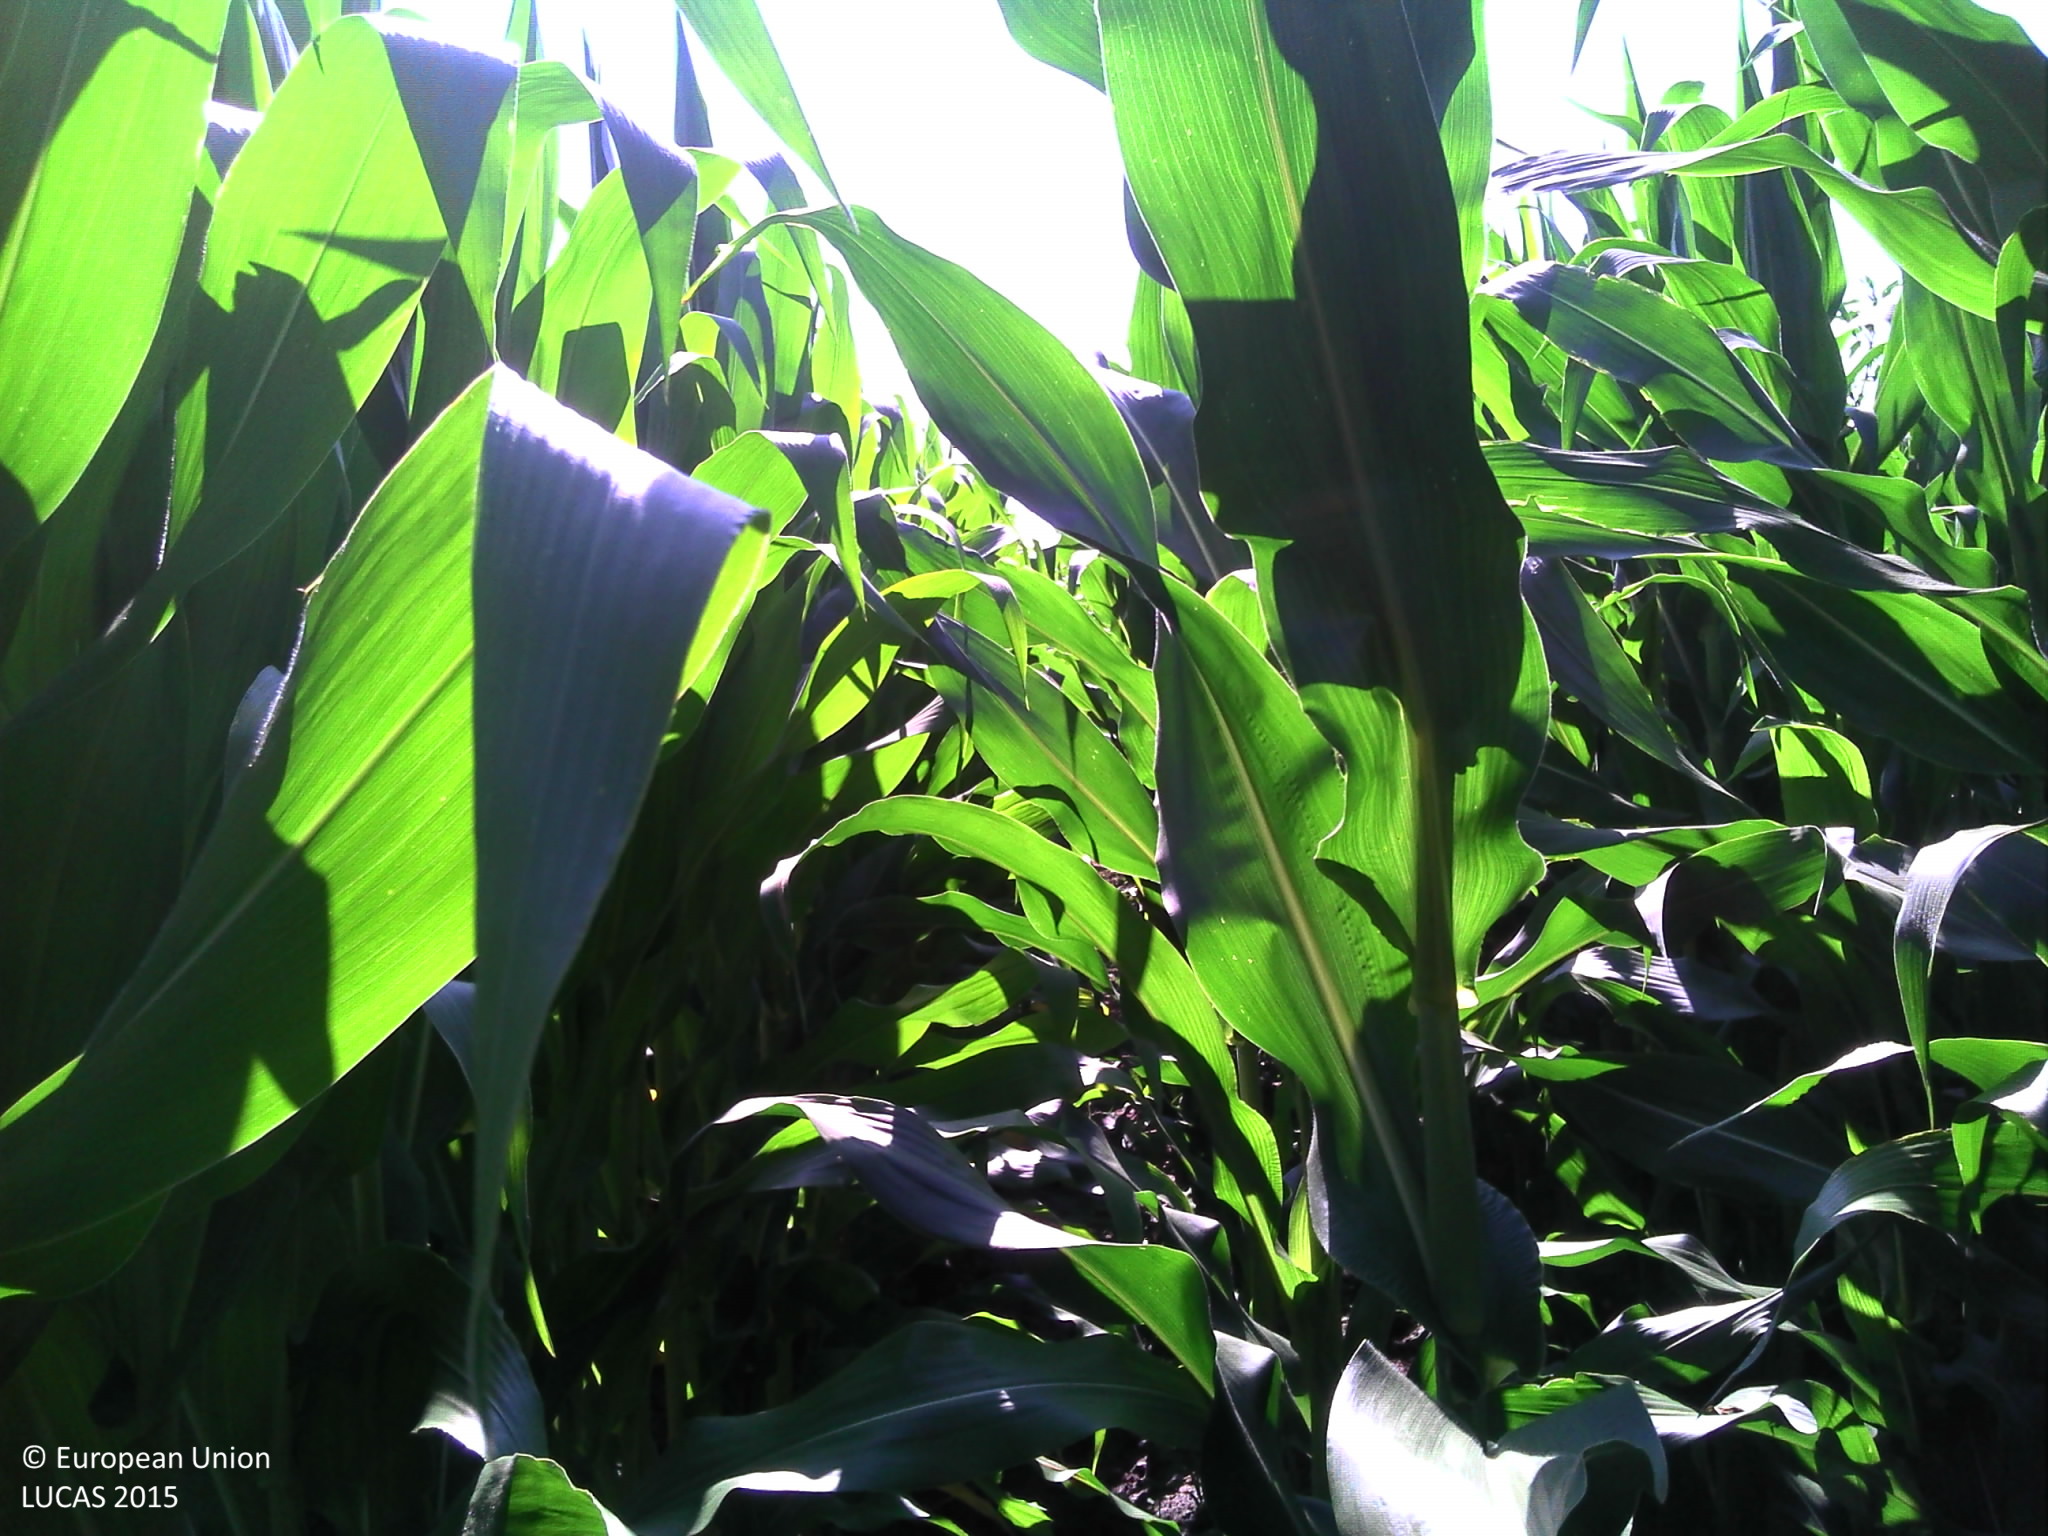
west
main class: Cropland
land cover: Maize
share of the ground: > 75 %
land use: Agriculture (excluding fallow land and kitchen gardens)
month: July
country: FR
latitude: 44.3064
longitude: -0.5069
